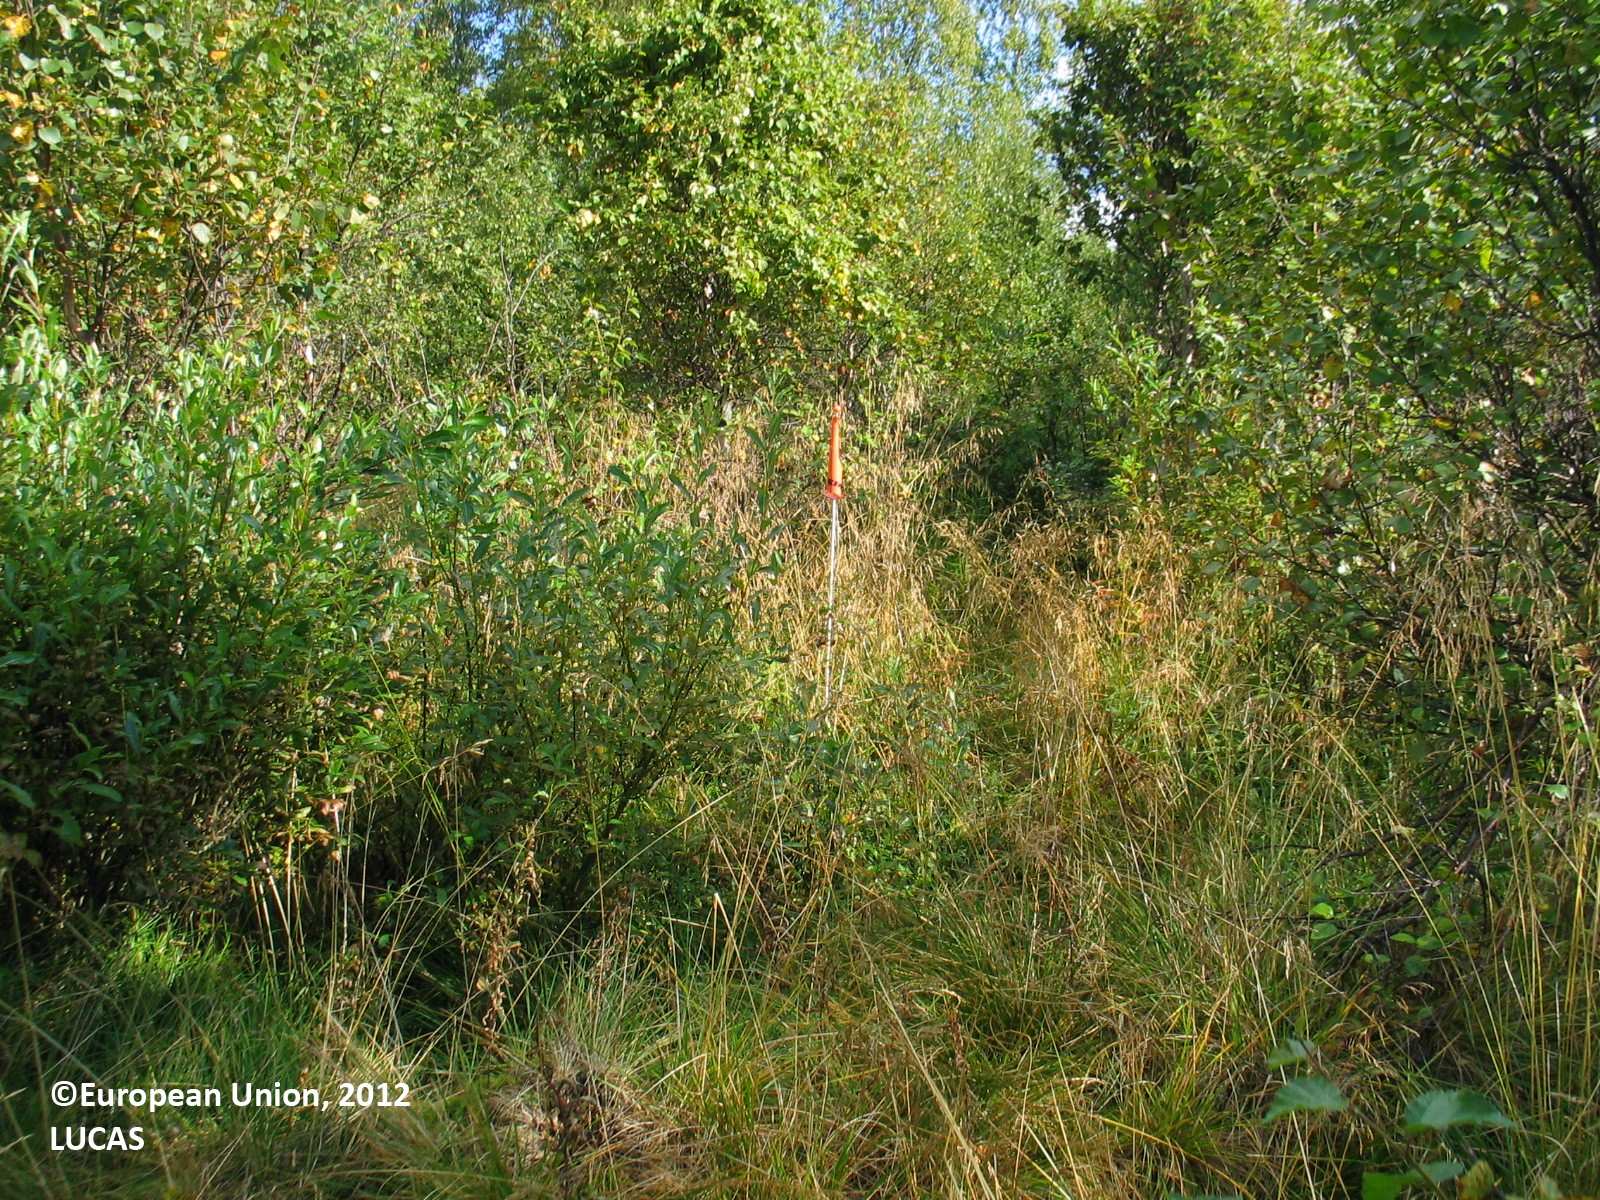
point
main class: Woodland
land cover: Broadleaved woodland
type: boreal forest
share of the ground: 25 - 50 %
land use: Forestry
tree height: > 5 m
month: August
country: FI
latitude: 65.5142
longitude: 26.4689
